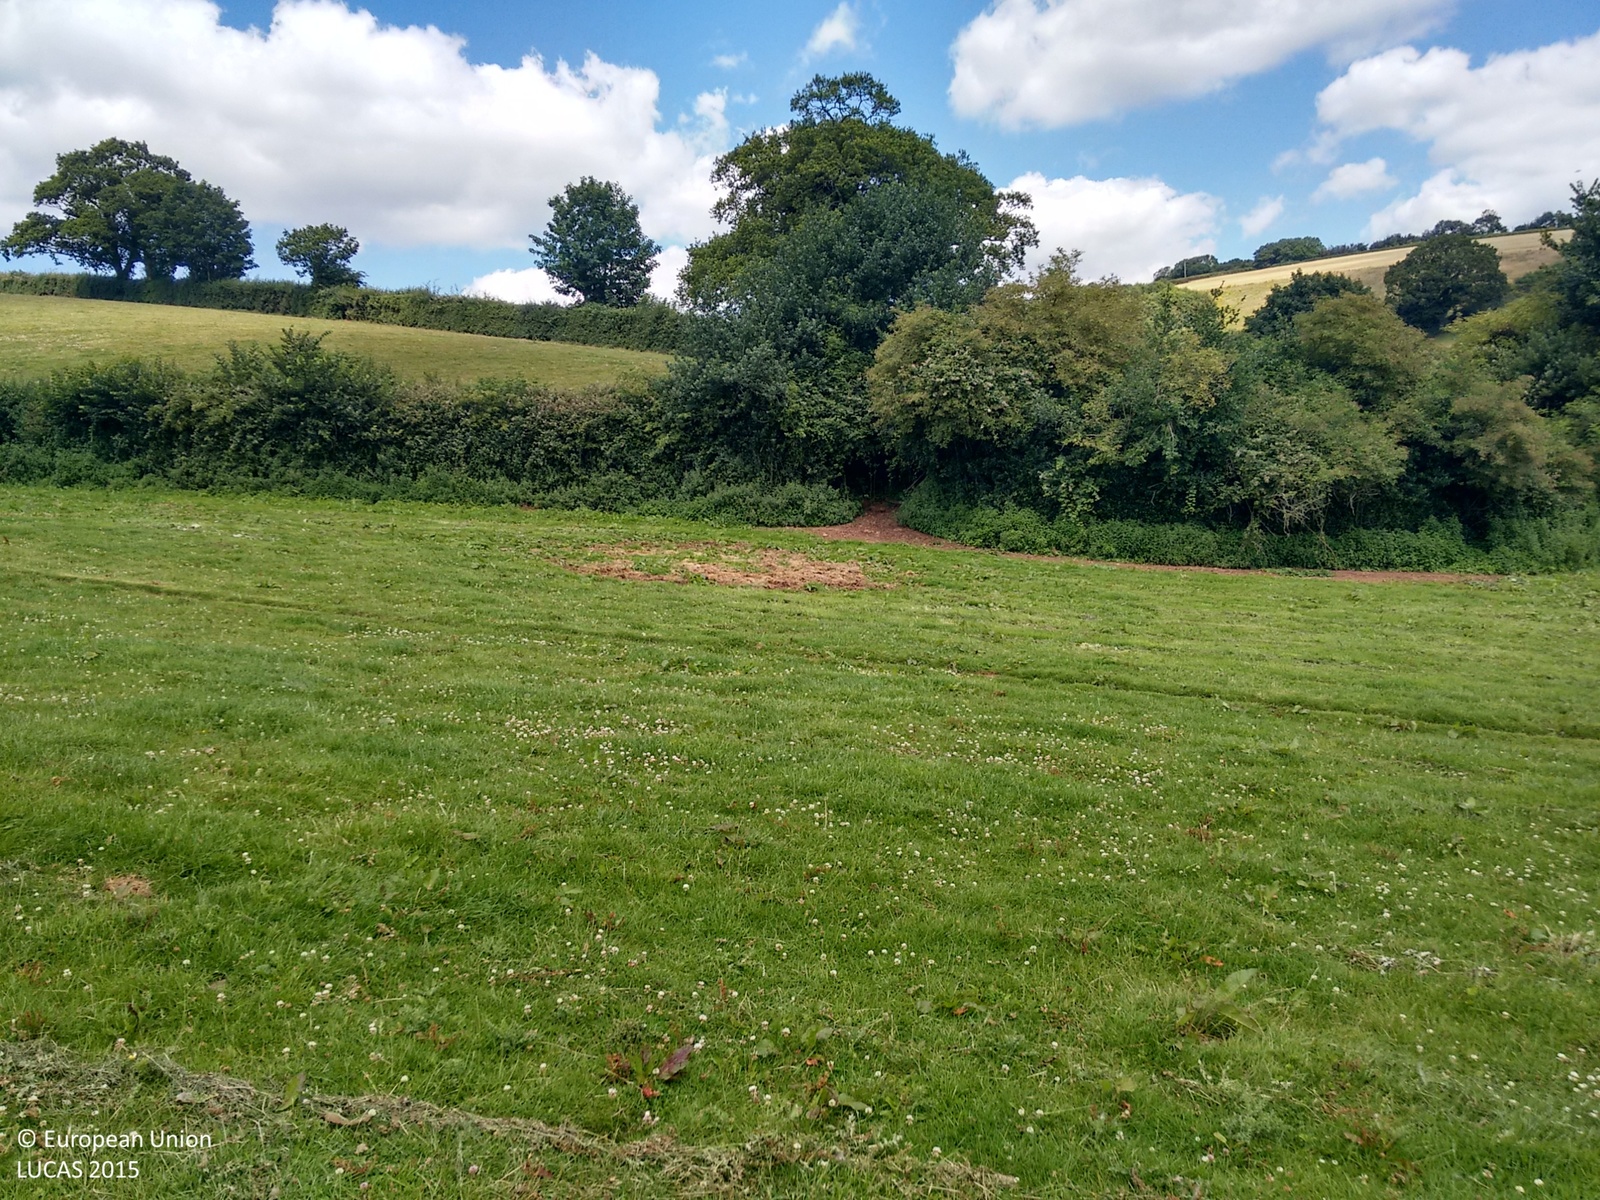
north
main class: Grassland
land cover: Grassland without tree/shrub cover
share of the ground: > 75 %
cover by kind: herbaceous plants 100 %
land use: Agriculture (excluding fallow land and kitchen gardens)
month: July
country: GB
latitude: 50.8243
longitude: -3.4414
